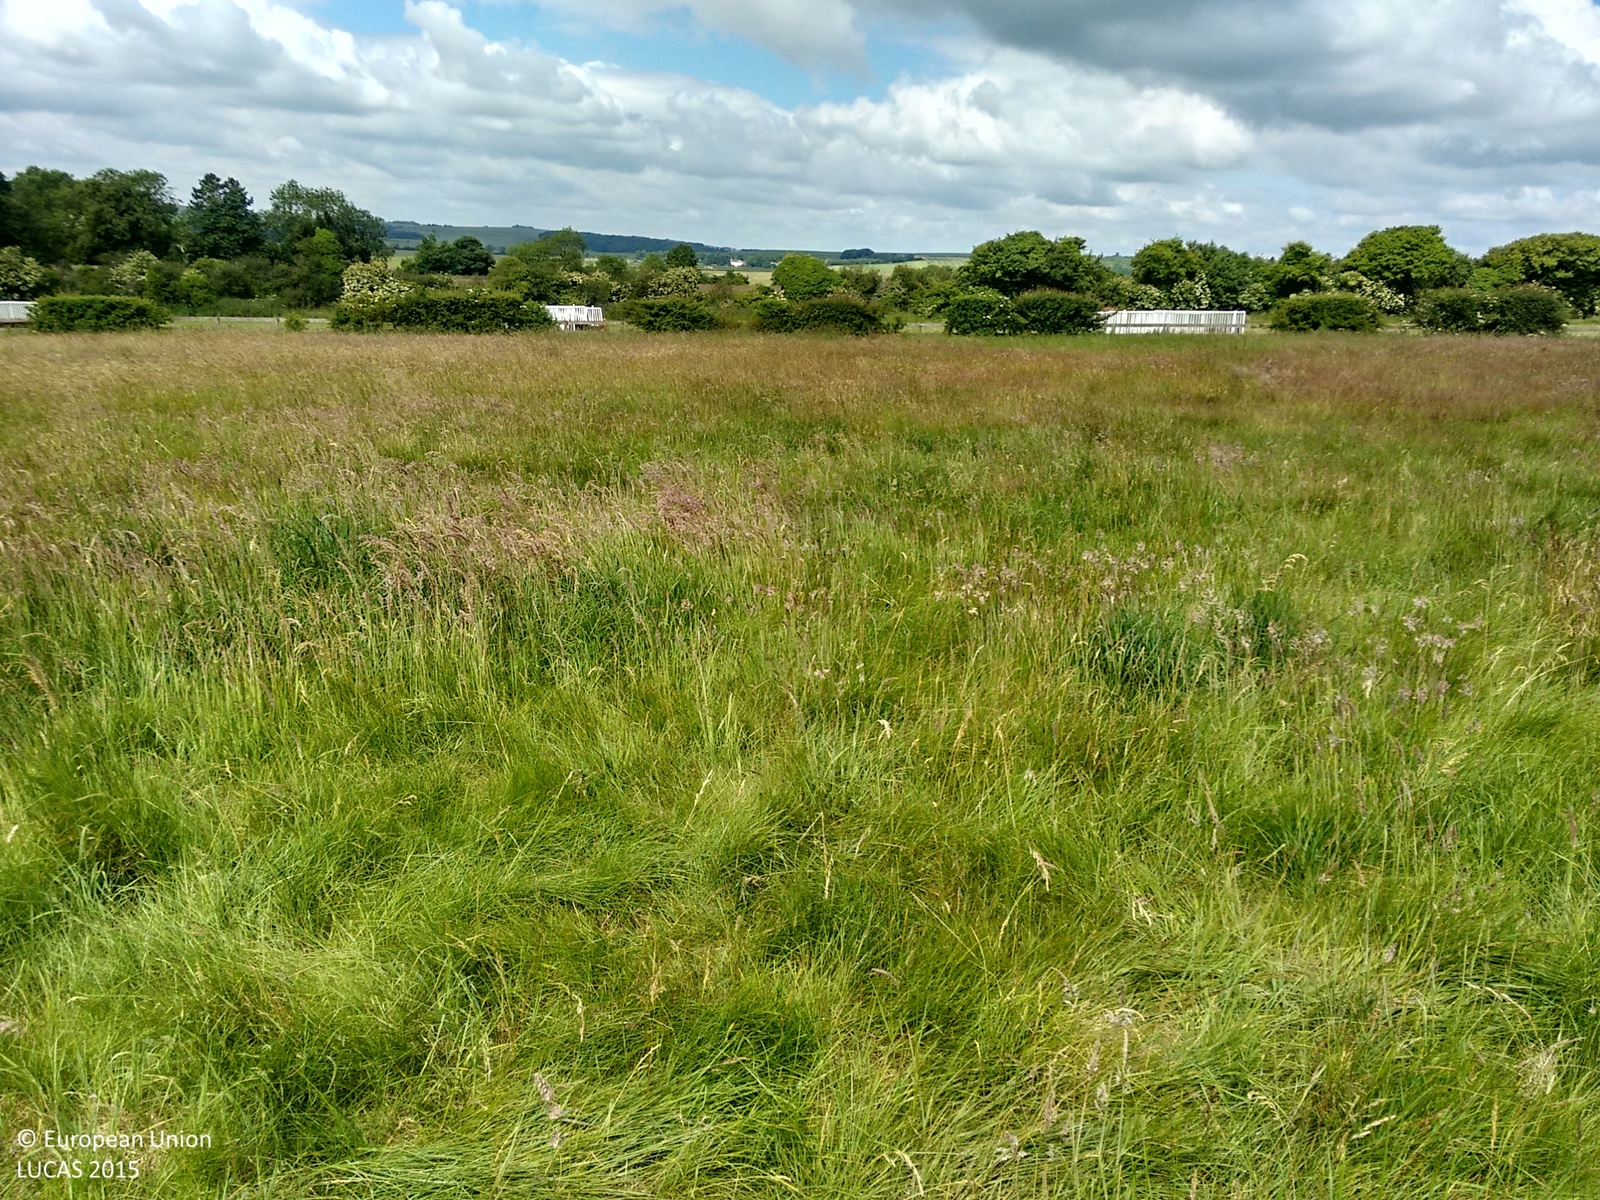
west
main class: Grassland
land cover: Grassland without tree/shrub cover
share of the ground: > 75 %
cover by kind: herbaceous plants 100 %
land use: Agriculture (excluding fallow land and kitchen gardens)
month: June
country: GB
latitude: 51.5220
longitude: -1.5384
